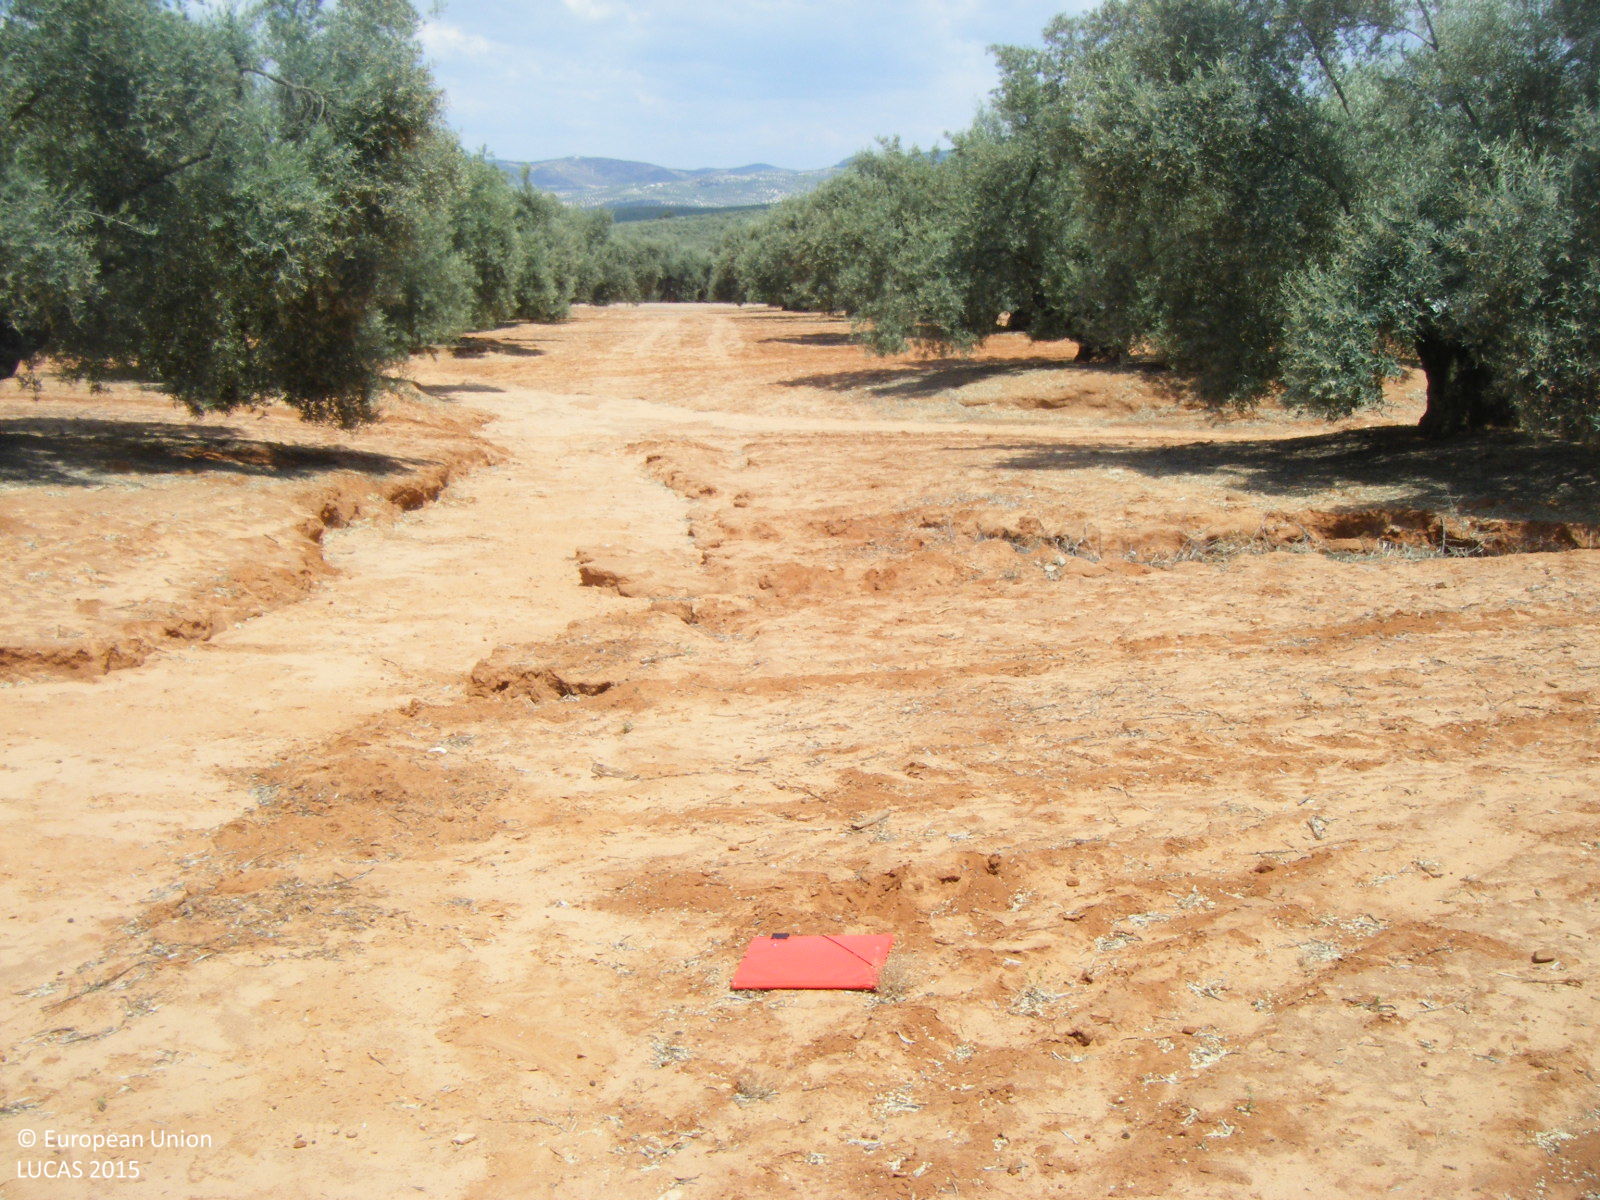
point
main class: Cropland
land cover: Olive groves
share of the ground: 10 - 25 %
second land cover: Other bare soil
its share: > 75 %
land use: Agriculture (excluding fallow land and kitchen gardens)
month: May
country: ES
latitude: 37.2144
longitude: -4.5251
